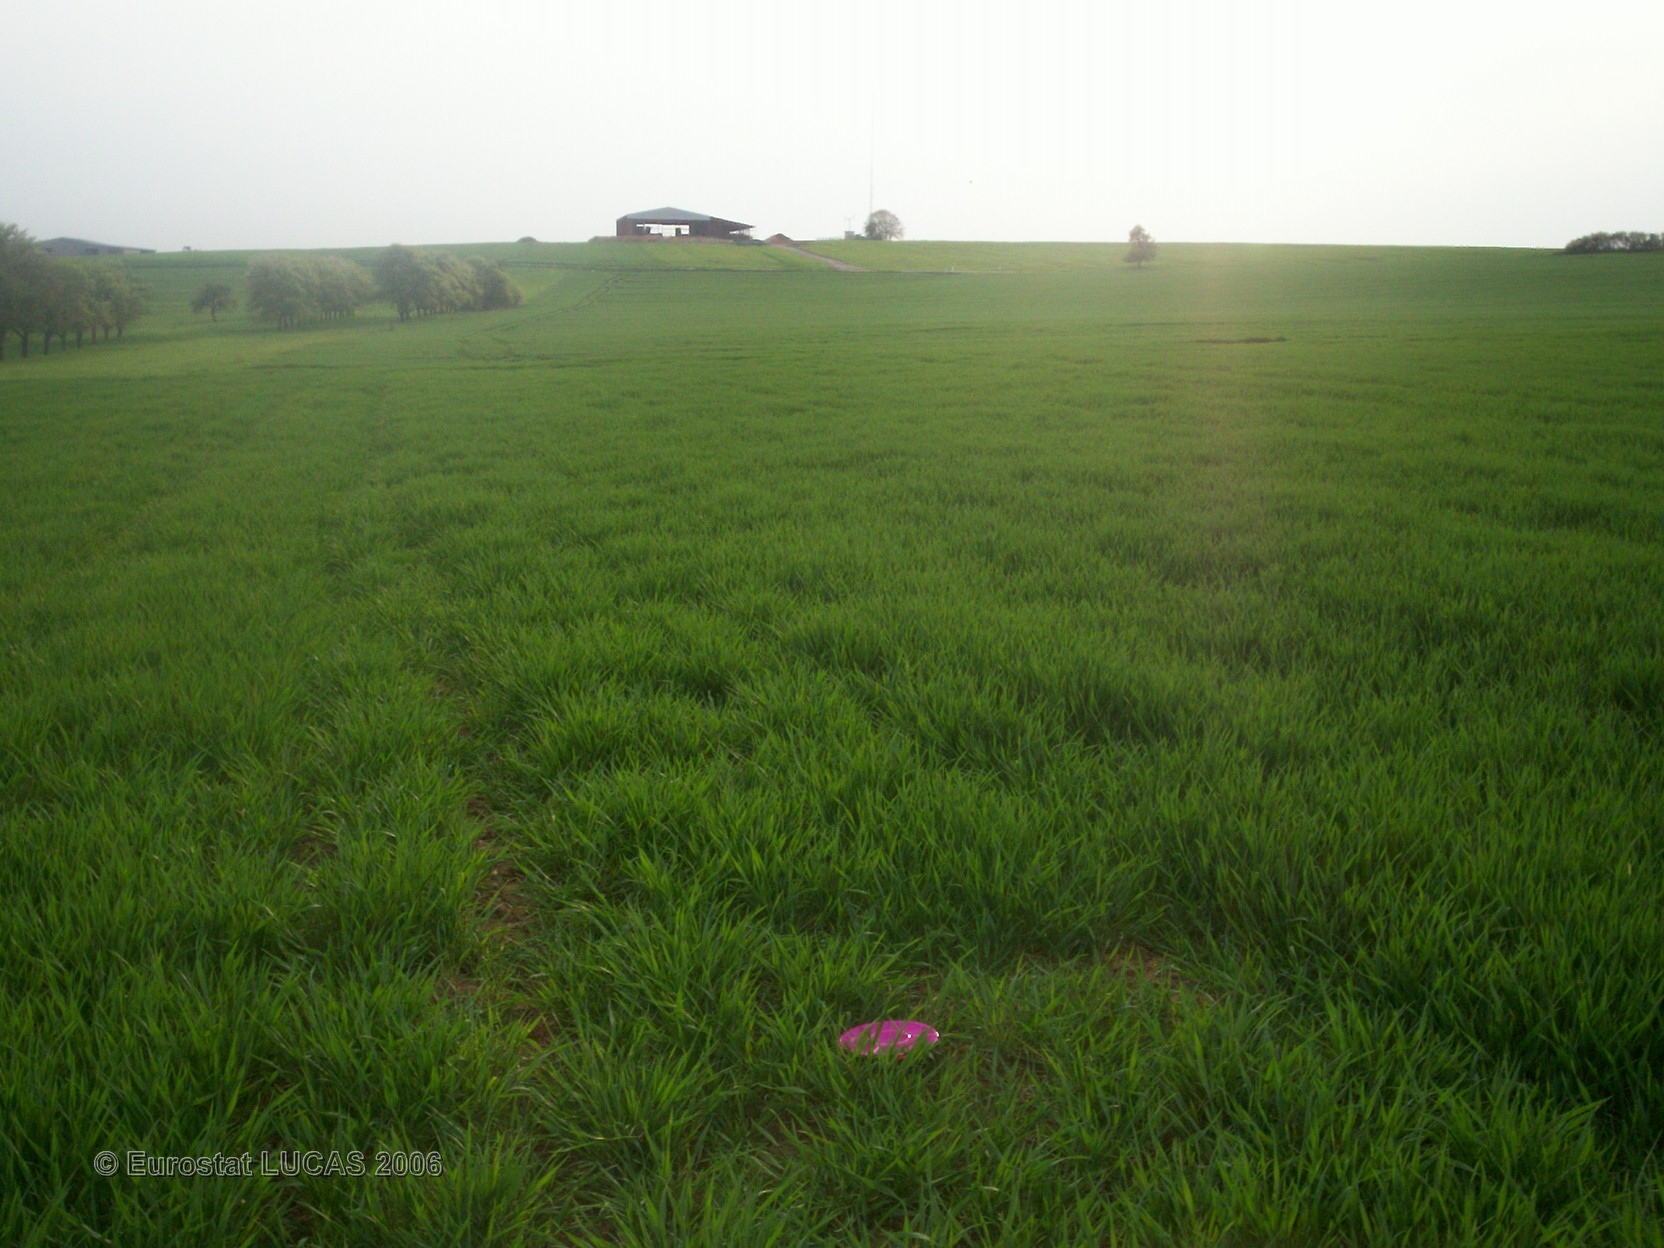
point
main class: Cropland
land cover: Common wheat
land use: Agriculture (excluding fallow land and kitchen gardens)
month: May
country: FR
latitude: 49.1362
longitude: 6.9712
